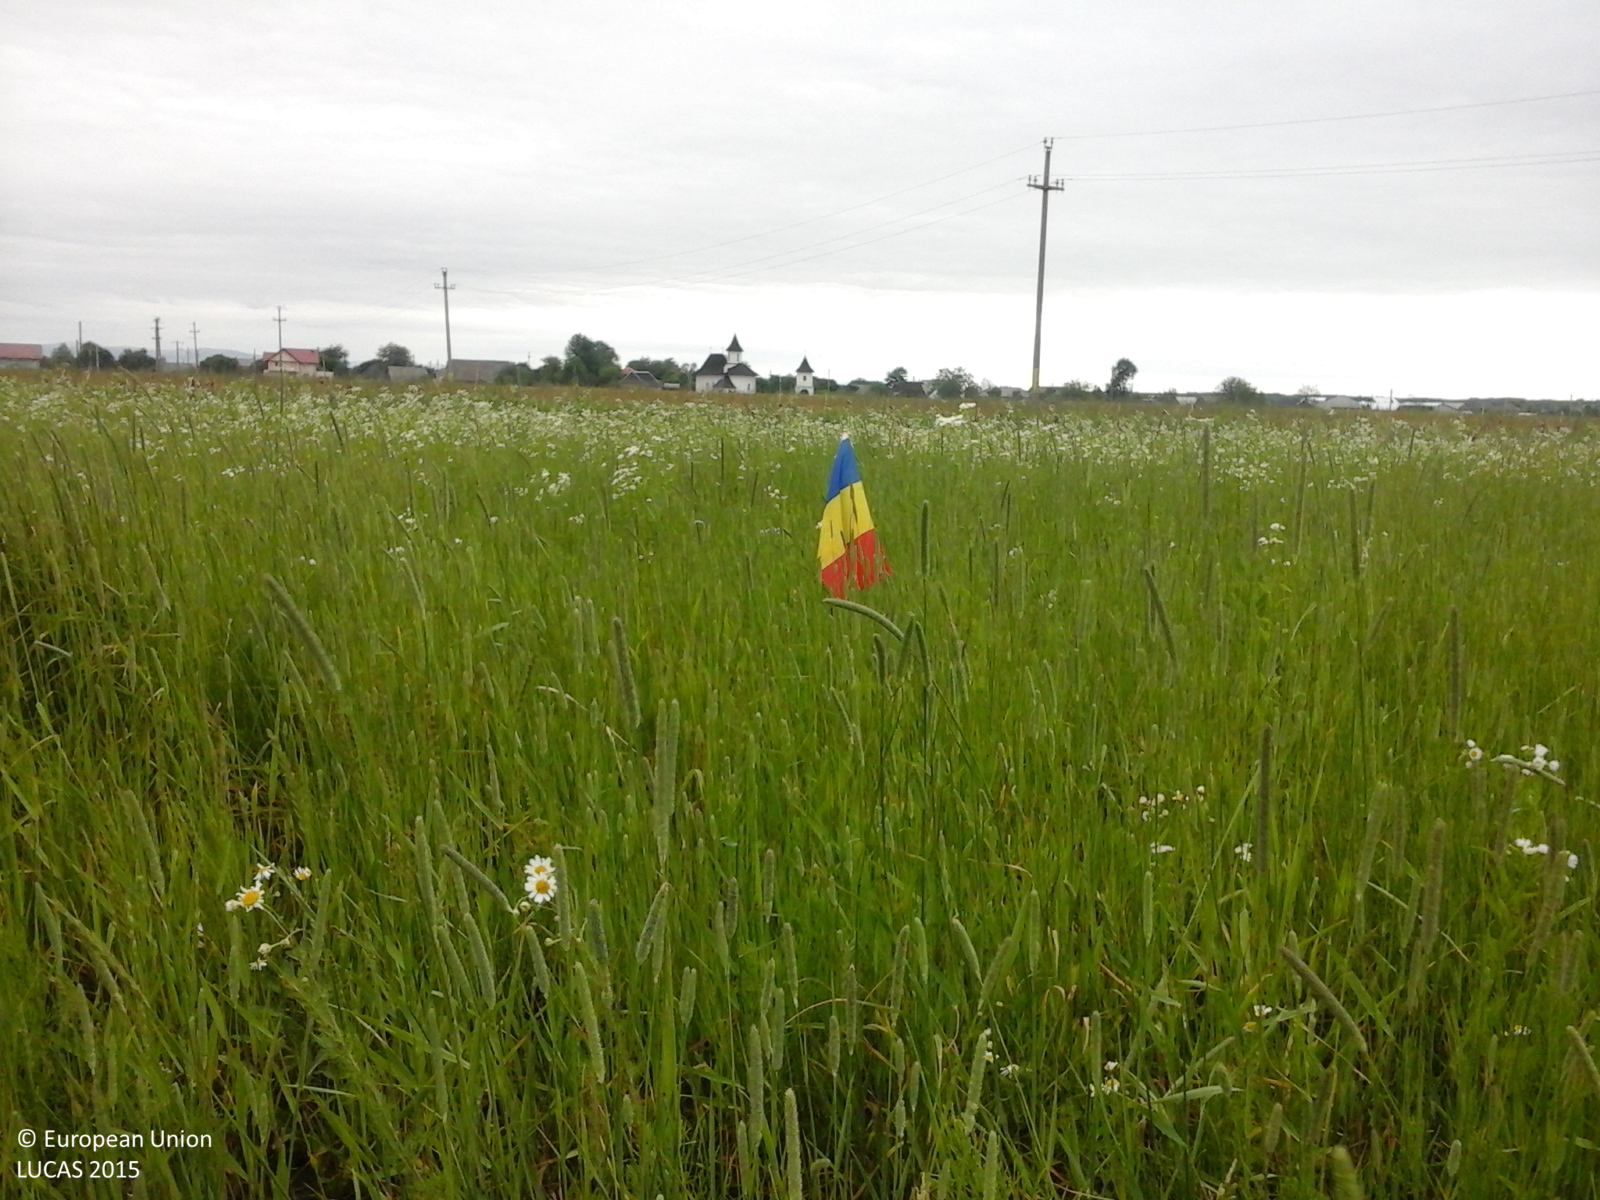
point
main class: Grassland
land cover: Grassland without tree/shrub cover
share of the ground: > 75 %
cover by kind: herbaceous plants 100 %
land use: Agriculture (excluding fallow land and kitchen gardens)
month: June
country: RO
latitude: 47.4557
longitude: 26.1963
